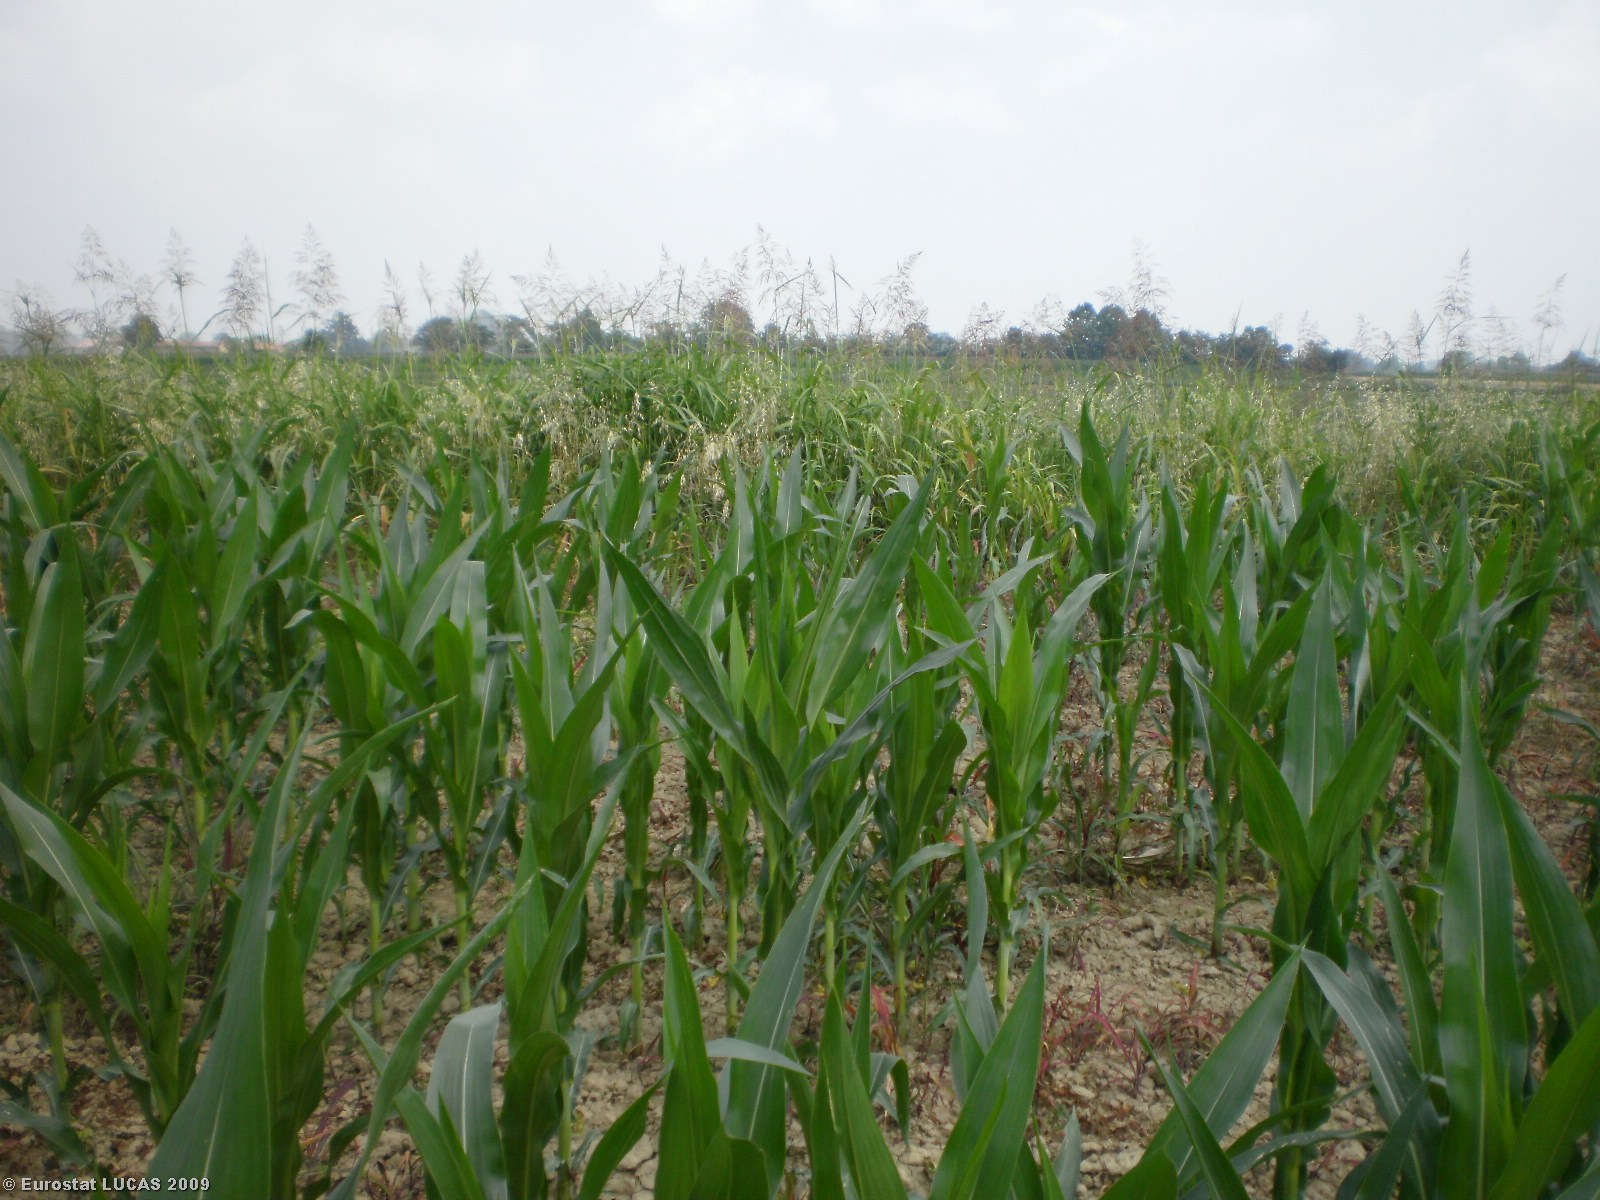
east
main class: Cropland
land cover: Maize
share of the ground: > 75 %
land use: Agriculture (excluding fallow land and kitchen gardens)
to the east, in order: Maize; Grass margins; Artificial constructions; Grass margins; Tomatoes; Ditches and canals; Tracks; Tomatoes; Grass margins; Ditches and canals; Grass margins; Maize
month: June
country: IT
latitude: 45.1075
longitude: 10.2664
